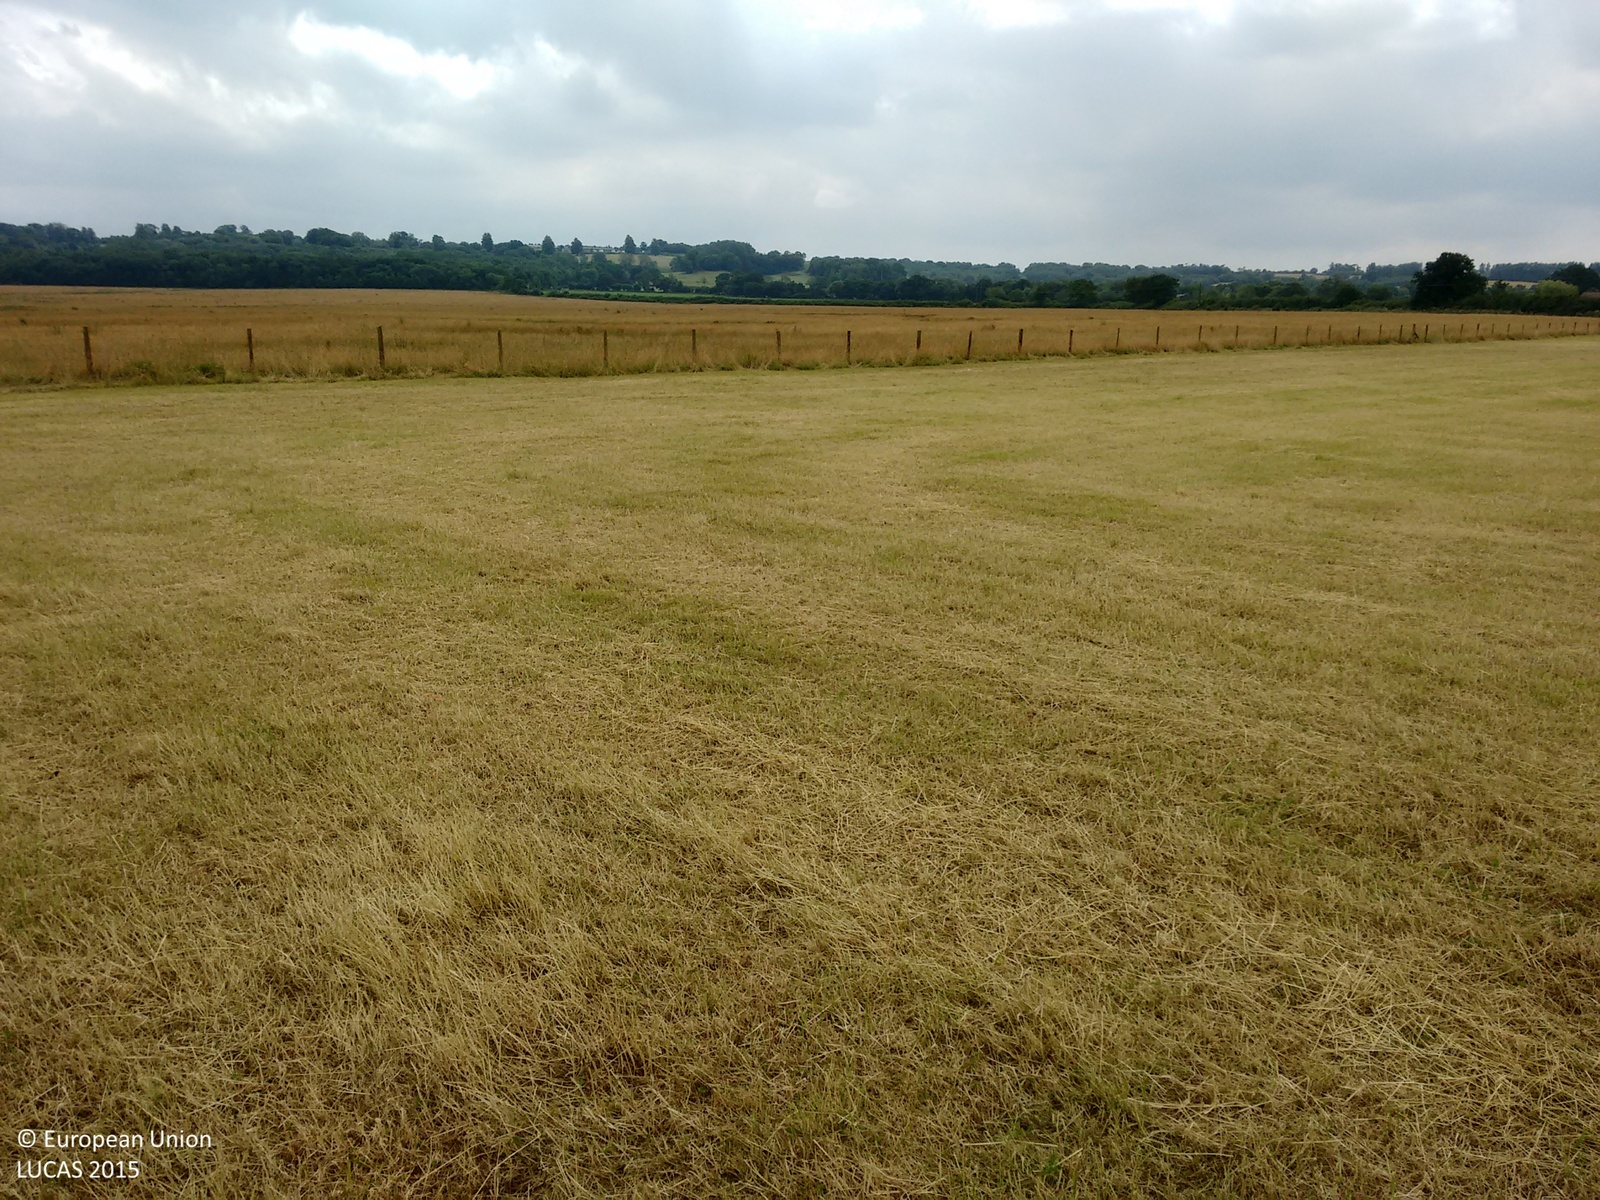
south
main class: Grassland
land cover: Grassland without tree/shrub cover
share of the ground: > 75 %
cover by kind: herbaceous plants 100 %
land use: Agriculture (excluding fallow land and kitchen gardens)
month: July
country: GB
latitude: 51.8092
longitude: -1.2007
